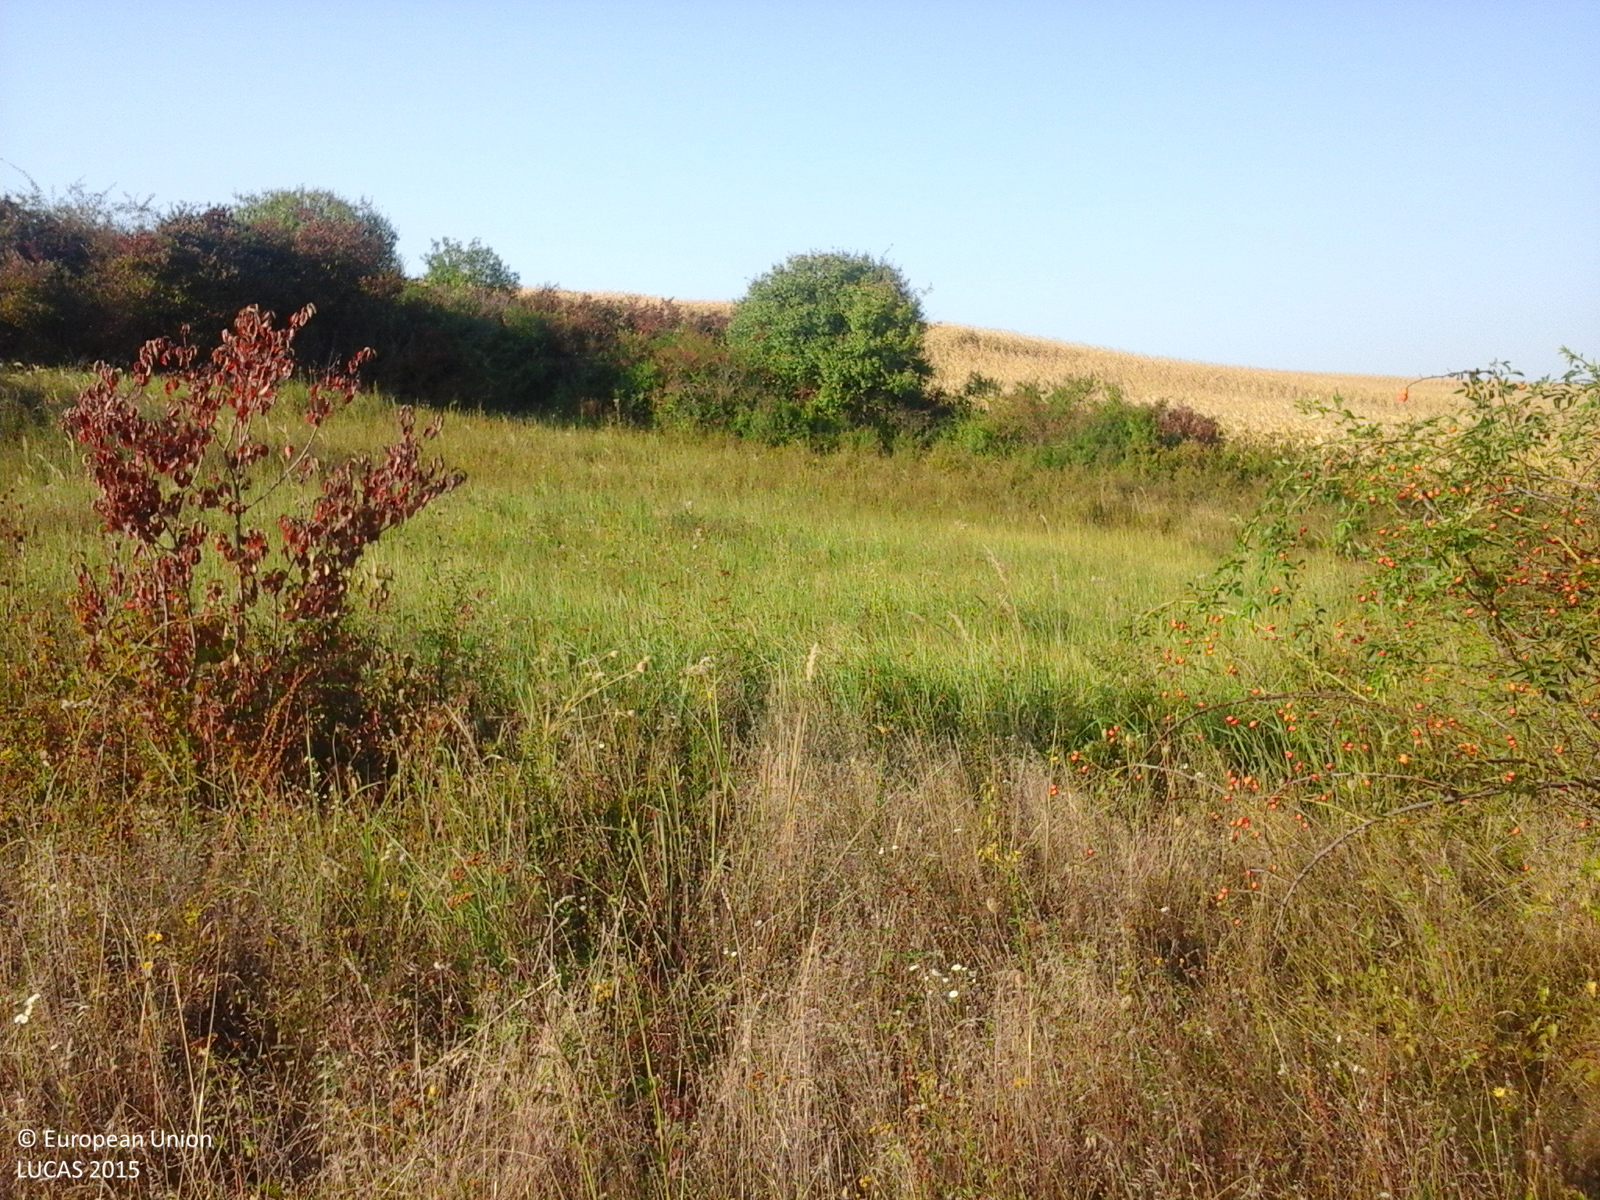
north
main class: Grassland
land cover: Spontaneously vegetated surfaces
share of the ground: > 75 %
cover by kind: herbaceous plants 100 %
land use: Fallow land
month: September
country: RO
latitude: 47.3139
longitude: 23.0689
